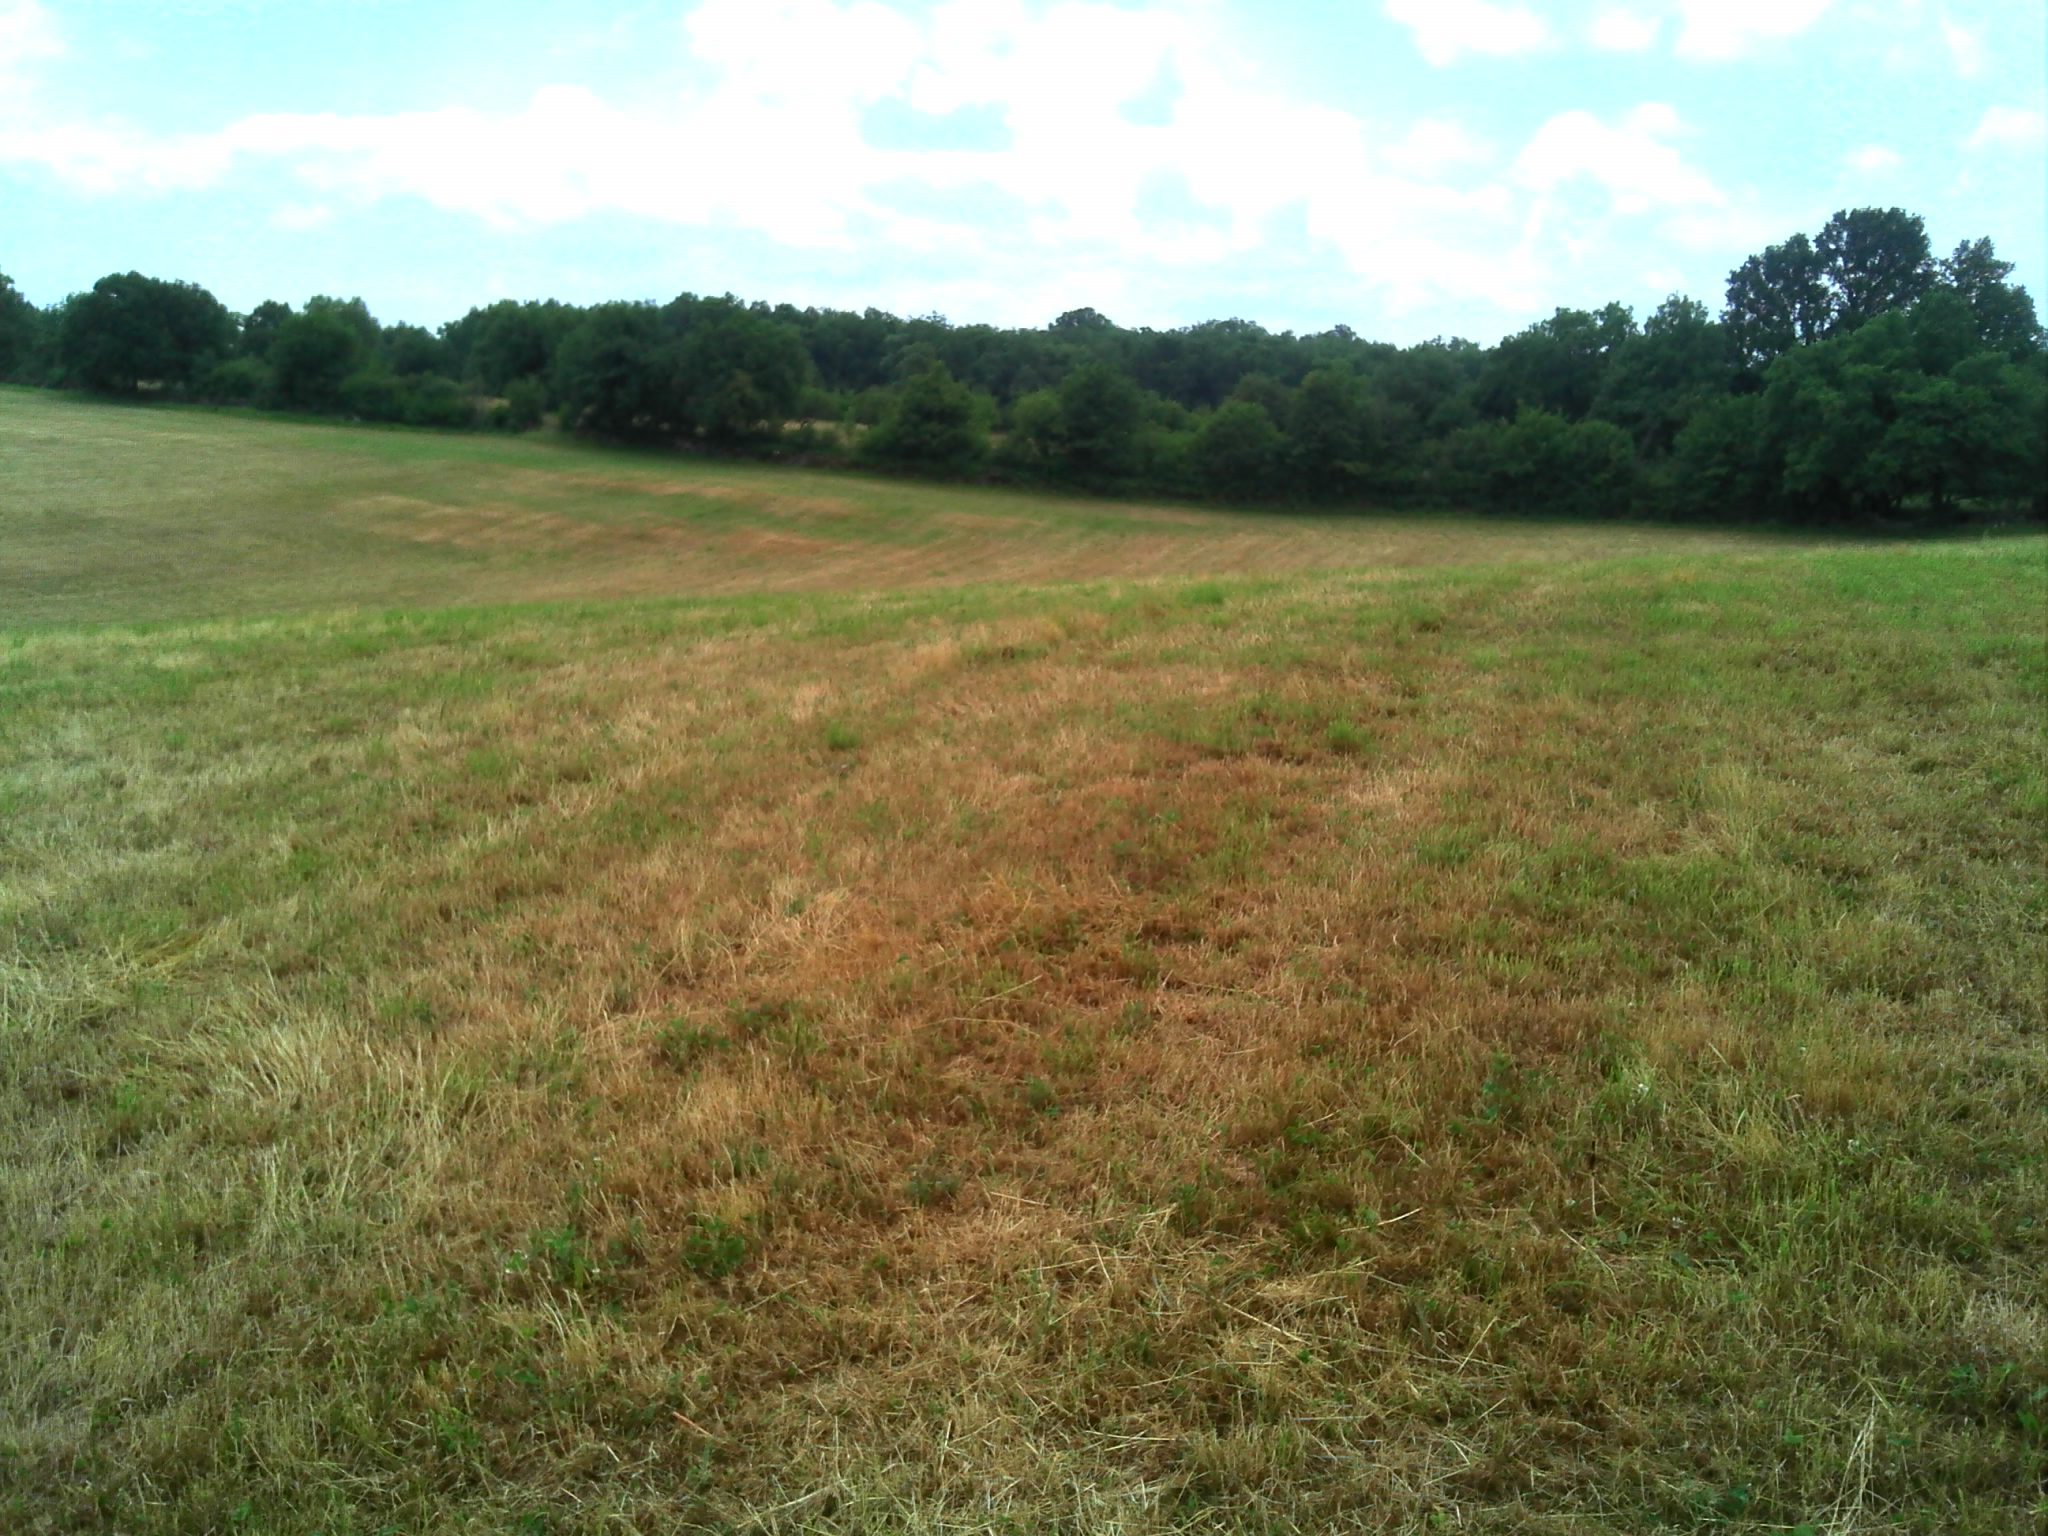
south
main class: Grassland
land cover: Grassland without tree/shrub cover
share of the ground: > 75 %
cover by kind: herbaceous plants 100 %
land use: Agriculture (excluding fallow land and kitchen gardens)
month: June
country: FR
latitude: 44.6967
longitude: 1.8088
